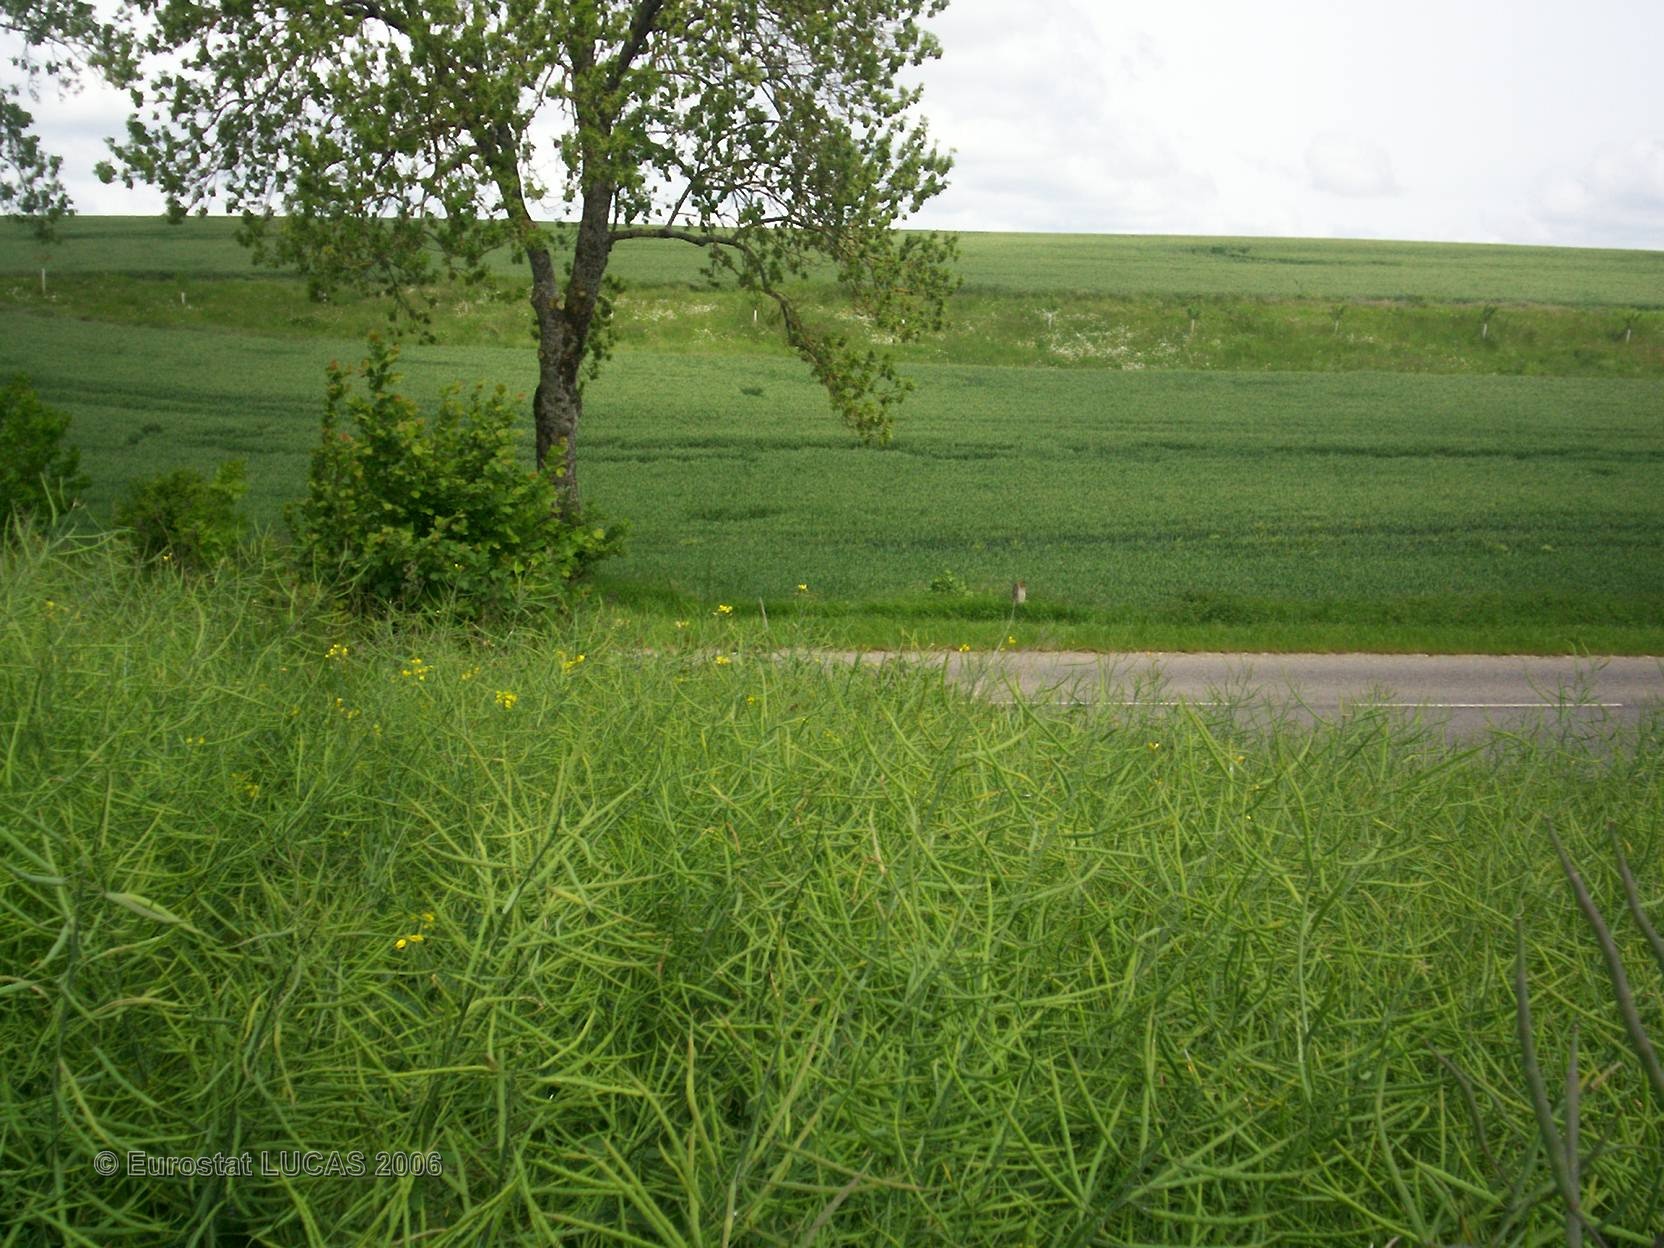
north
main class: Cropland
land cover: Rape and turnip rape
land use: Agriculture (excluding fallow land and kitchen gardens)
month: June
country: FR
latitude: 49.2307
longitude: 5.0679
